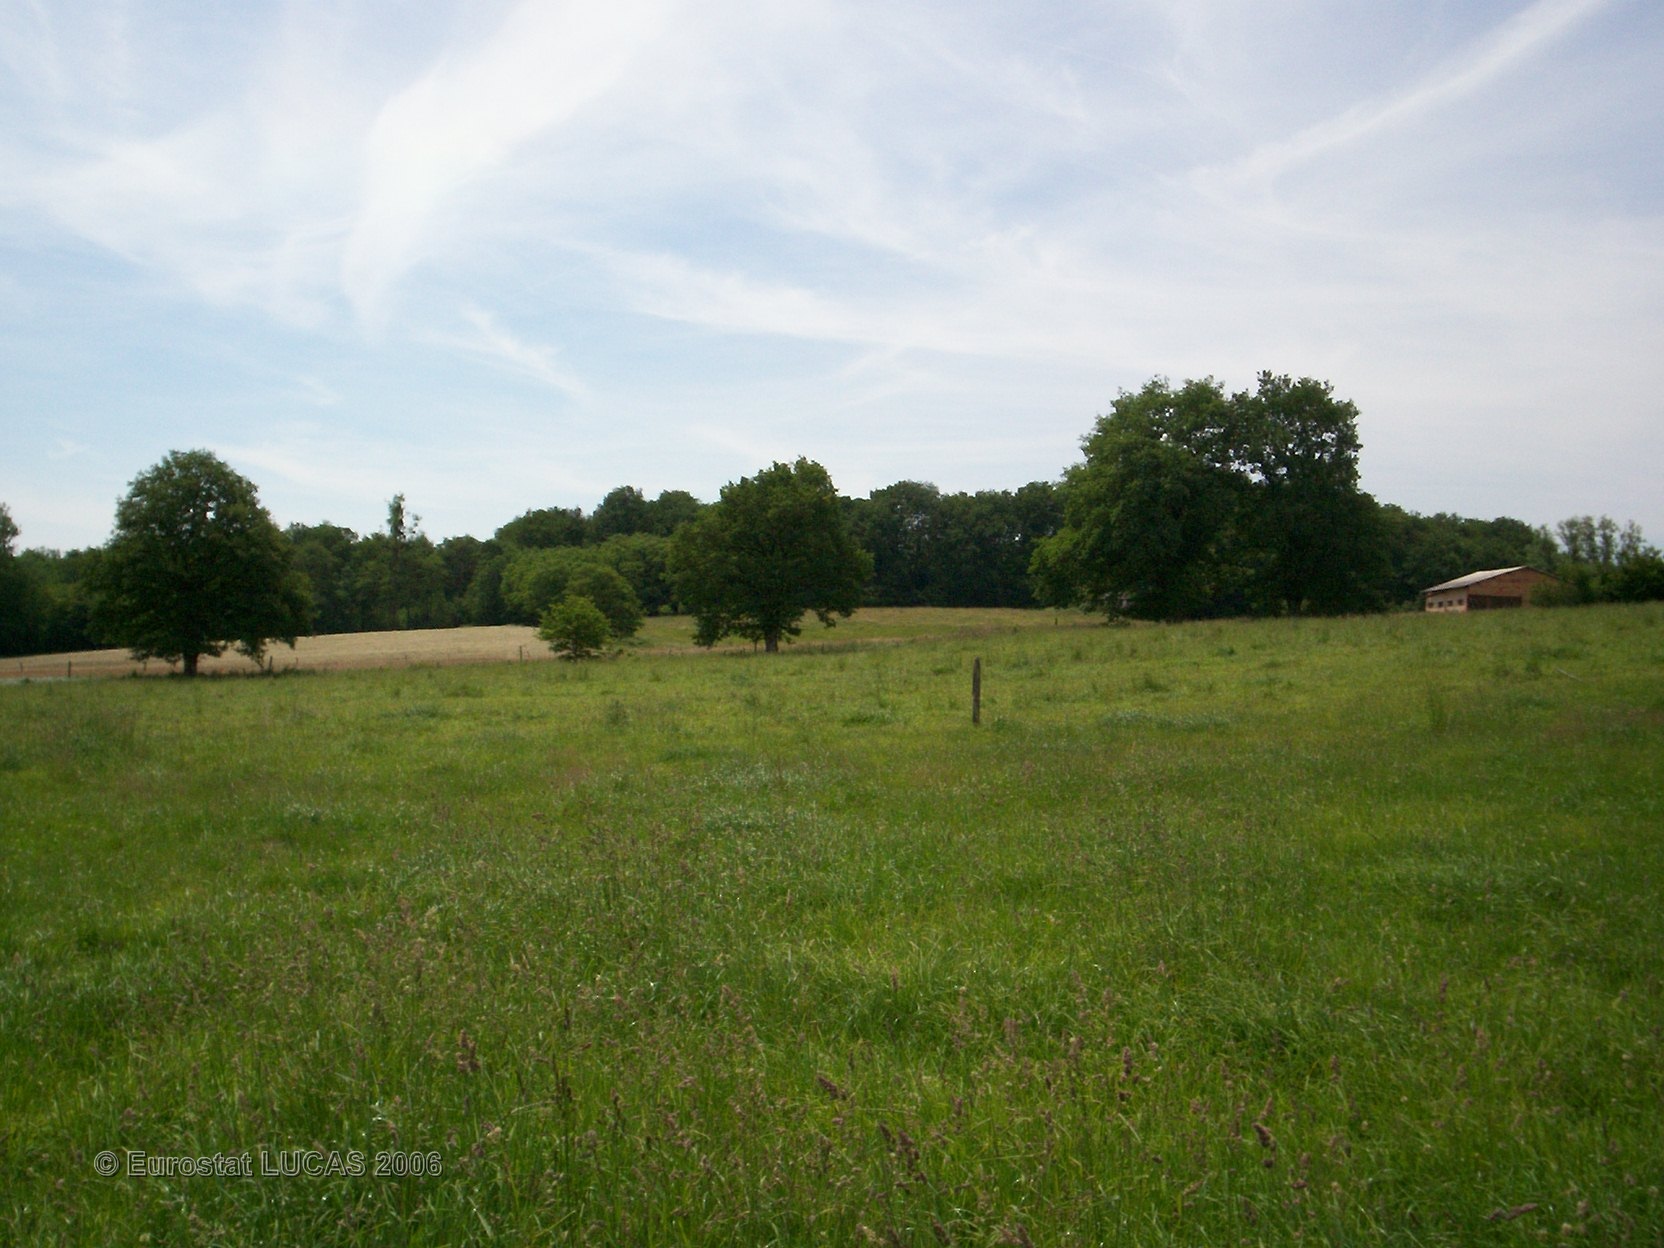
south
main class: Grassland
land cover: Grassland without tree/shrub cover
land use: Agriculture (excluding fallow land and kitchen gardens)
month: June
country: FR
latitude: 46.2668
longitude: 5.3190
